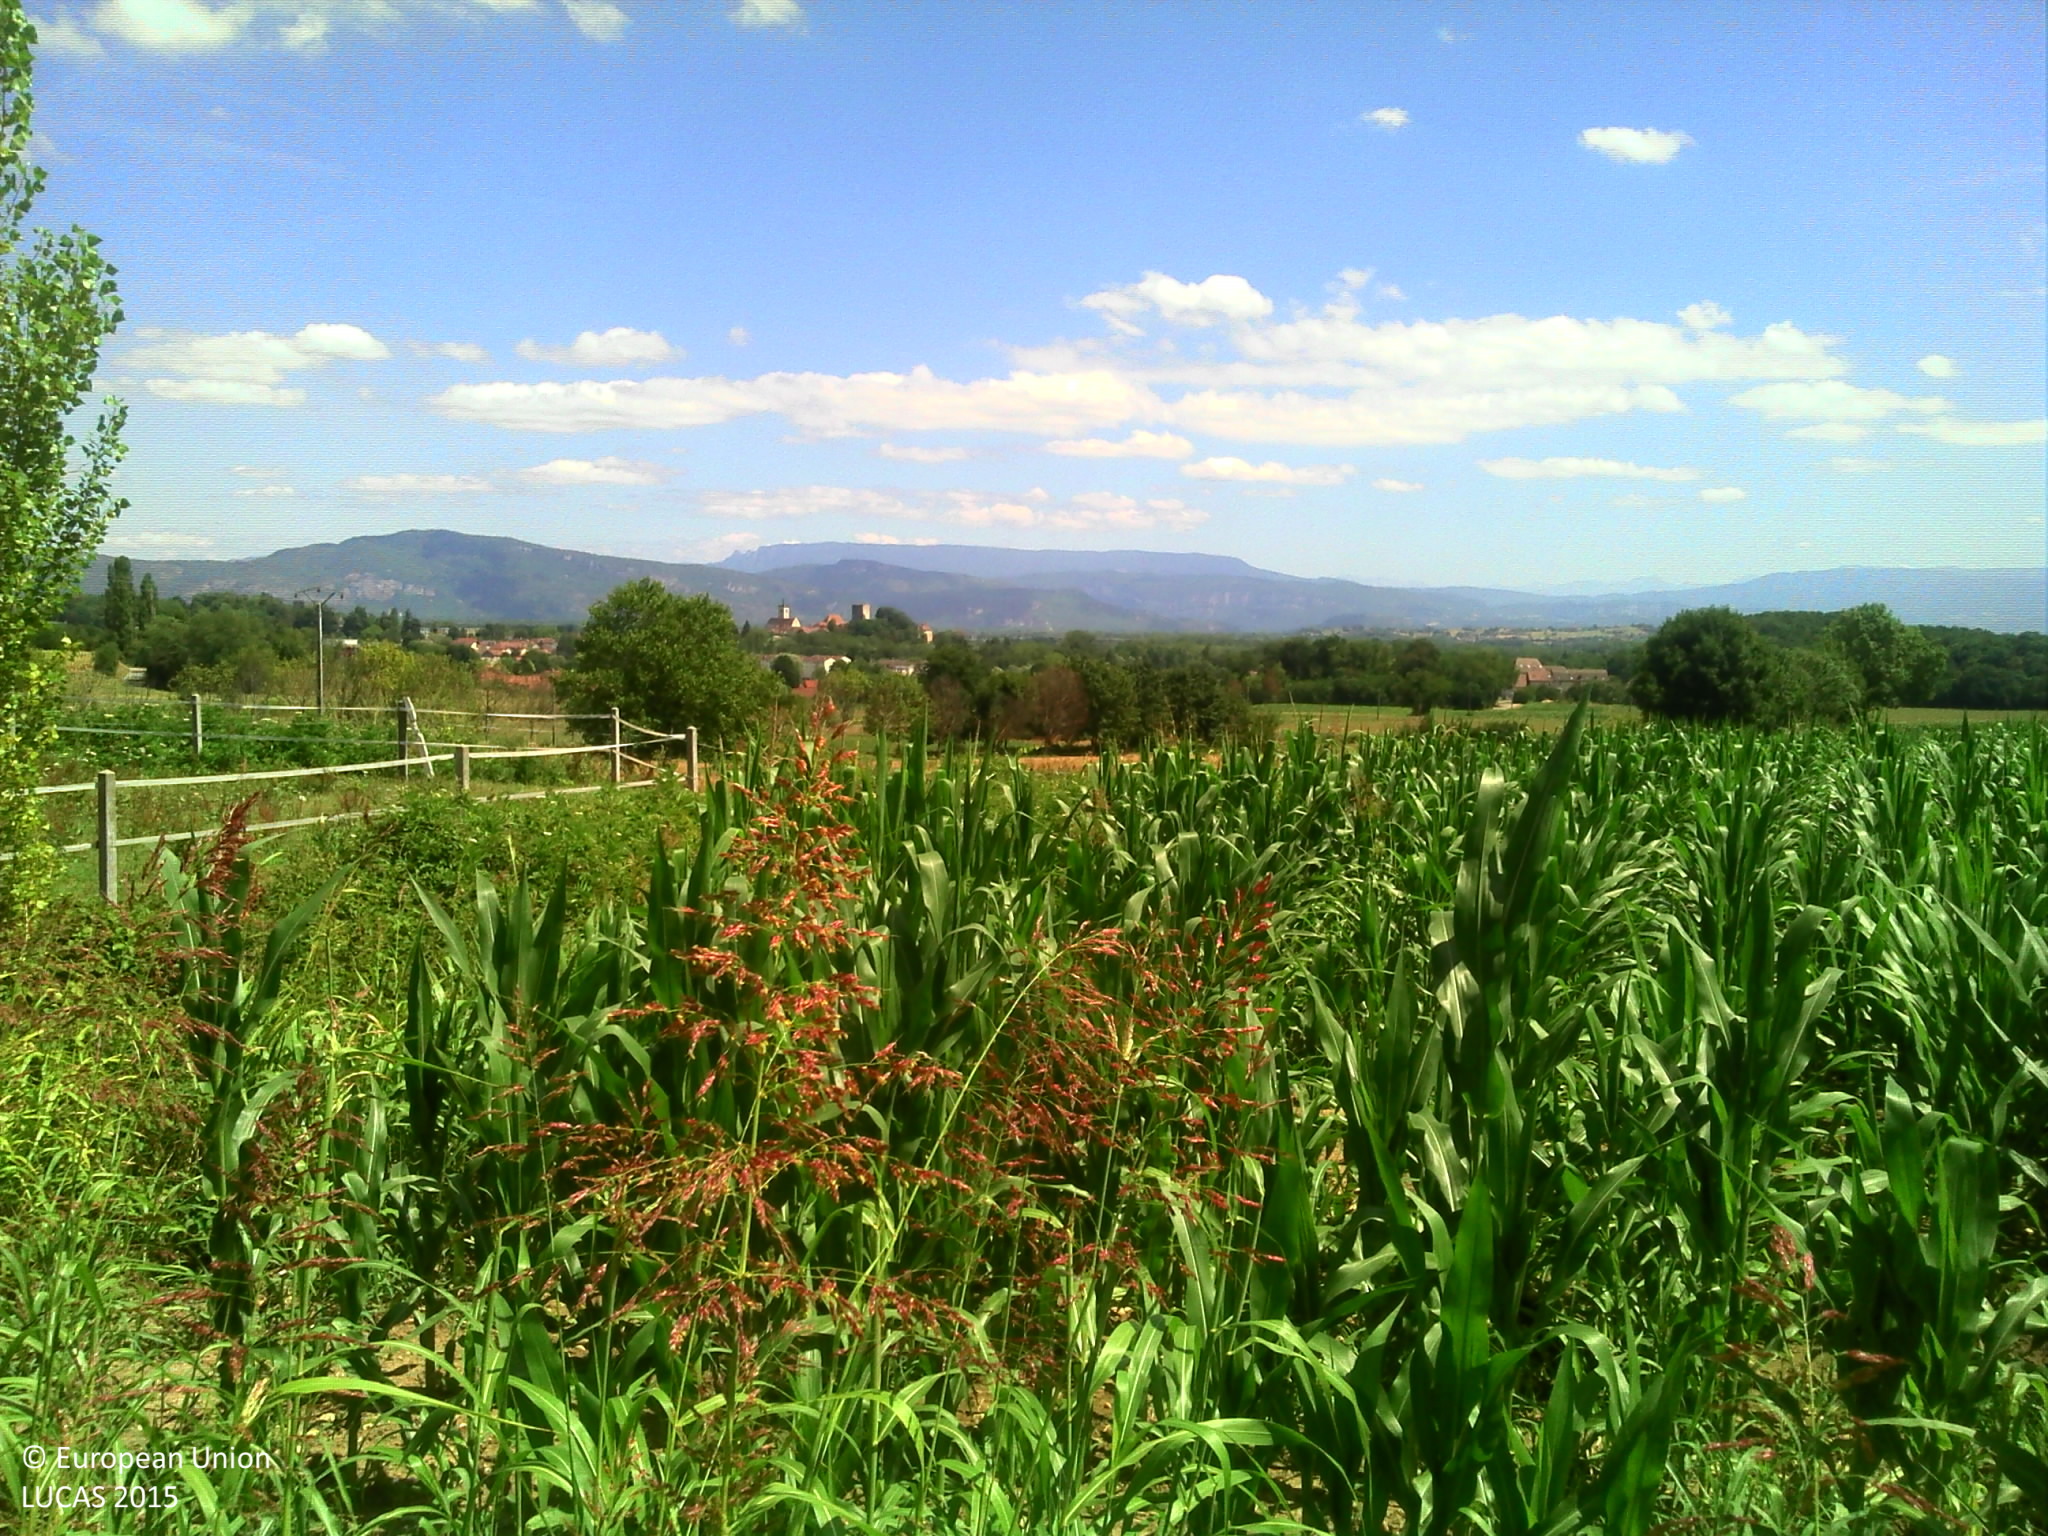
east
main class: Grassland
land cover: Spontaneously vegetated surfaces
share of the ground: > 75 %
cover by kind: herbaceous plants 100 %
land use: Agriculture (excluding fallow land and kitchen gardens)
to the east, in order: Spontaneously vegetated surfaces; Maize; Lines of trees; Fences; Grassland without tree/shrub cover; Electric lines; Grassland without tree/shrub cover; Fences; Lines of trees; Tracks; Lines of trees; Ditches and canals; Grassland without tree/shrub cover; Lines of trees; Electric lines; Grassland without tree/shrub cover
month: July
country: FR
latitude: 45.6769
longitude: 5.4468
